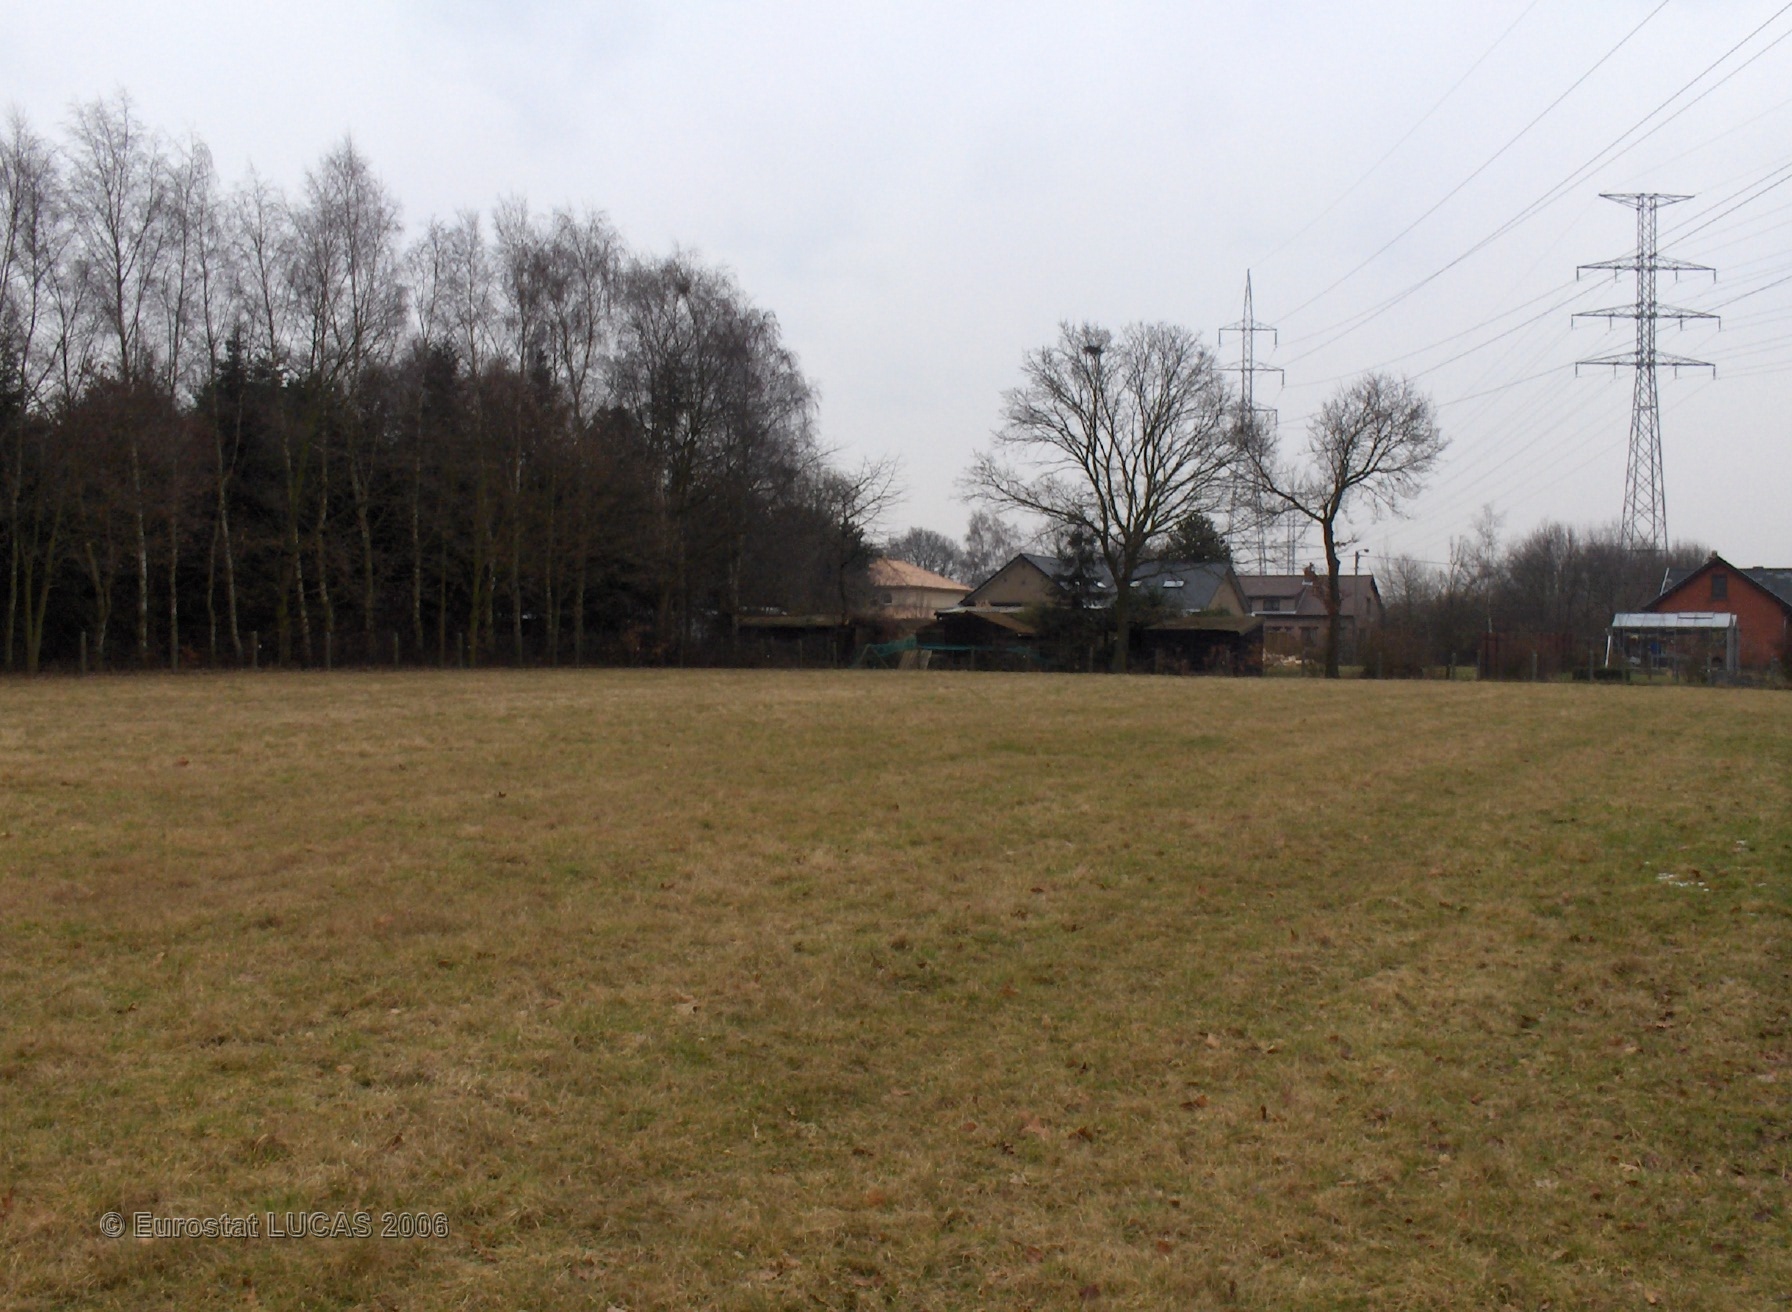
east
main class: Woodland
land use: Residential
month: March
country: BE
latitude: 51.0554
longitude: 5.1896
